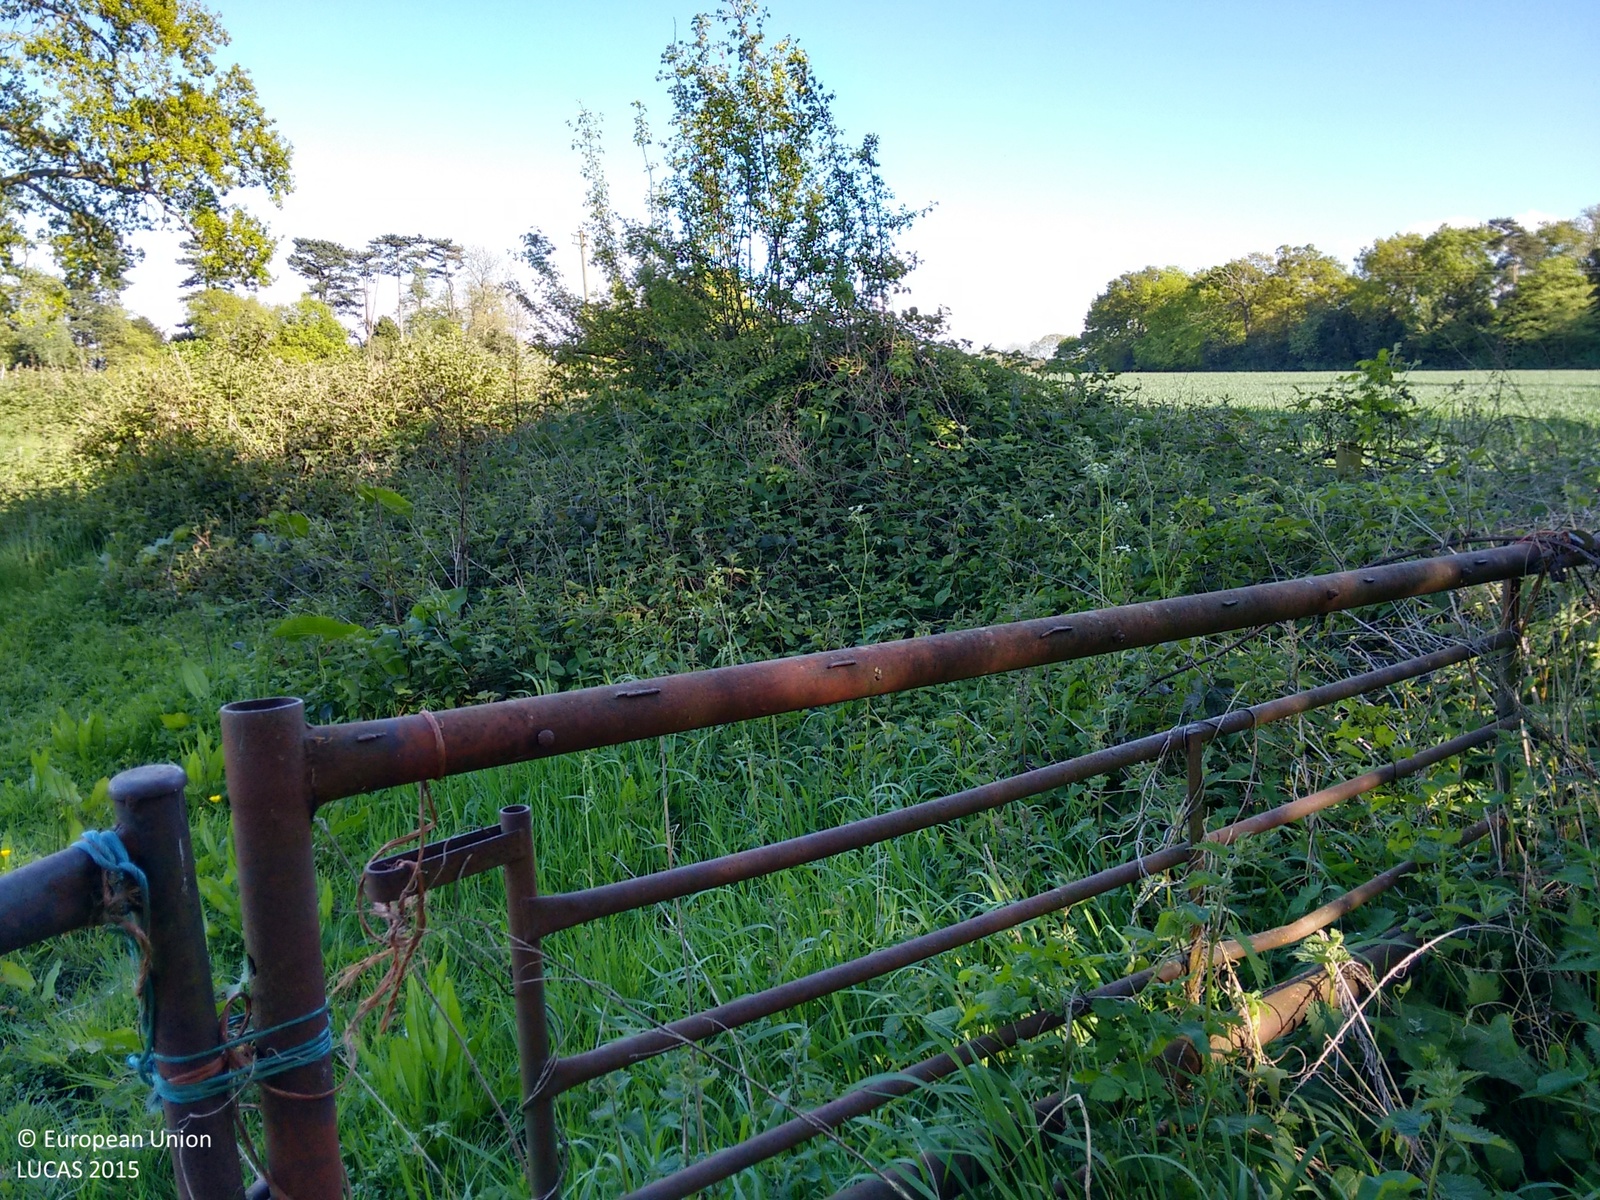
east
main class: Grassland
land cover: Grassland without tree/shrub cover
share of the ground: > 75 %
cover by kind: herbaceous plants 100 %
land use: Agriculture (excluding fallow land and kitchen gardens)
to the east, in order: Grassland without tree/shrub cover; Single bushes/trees; Grassland without tree/shrub cover; Fences; Grassland with sparse tree/shrub cover; Fences; Broadleaved woodland; Fences; Grassland with sparse tree/shrub cover
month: May
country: GB
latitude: 52.2716
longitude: -1.6748
